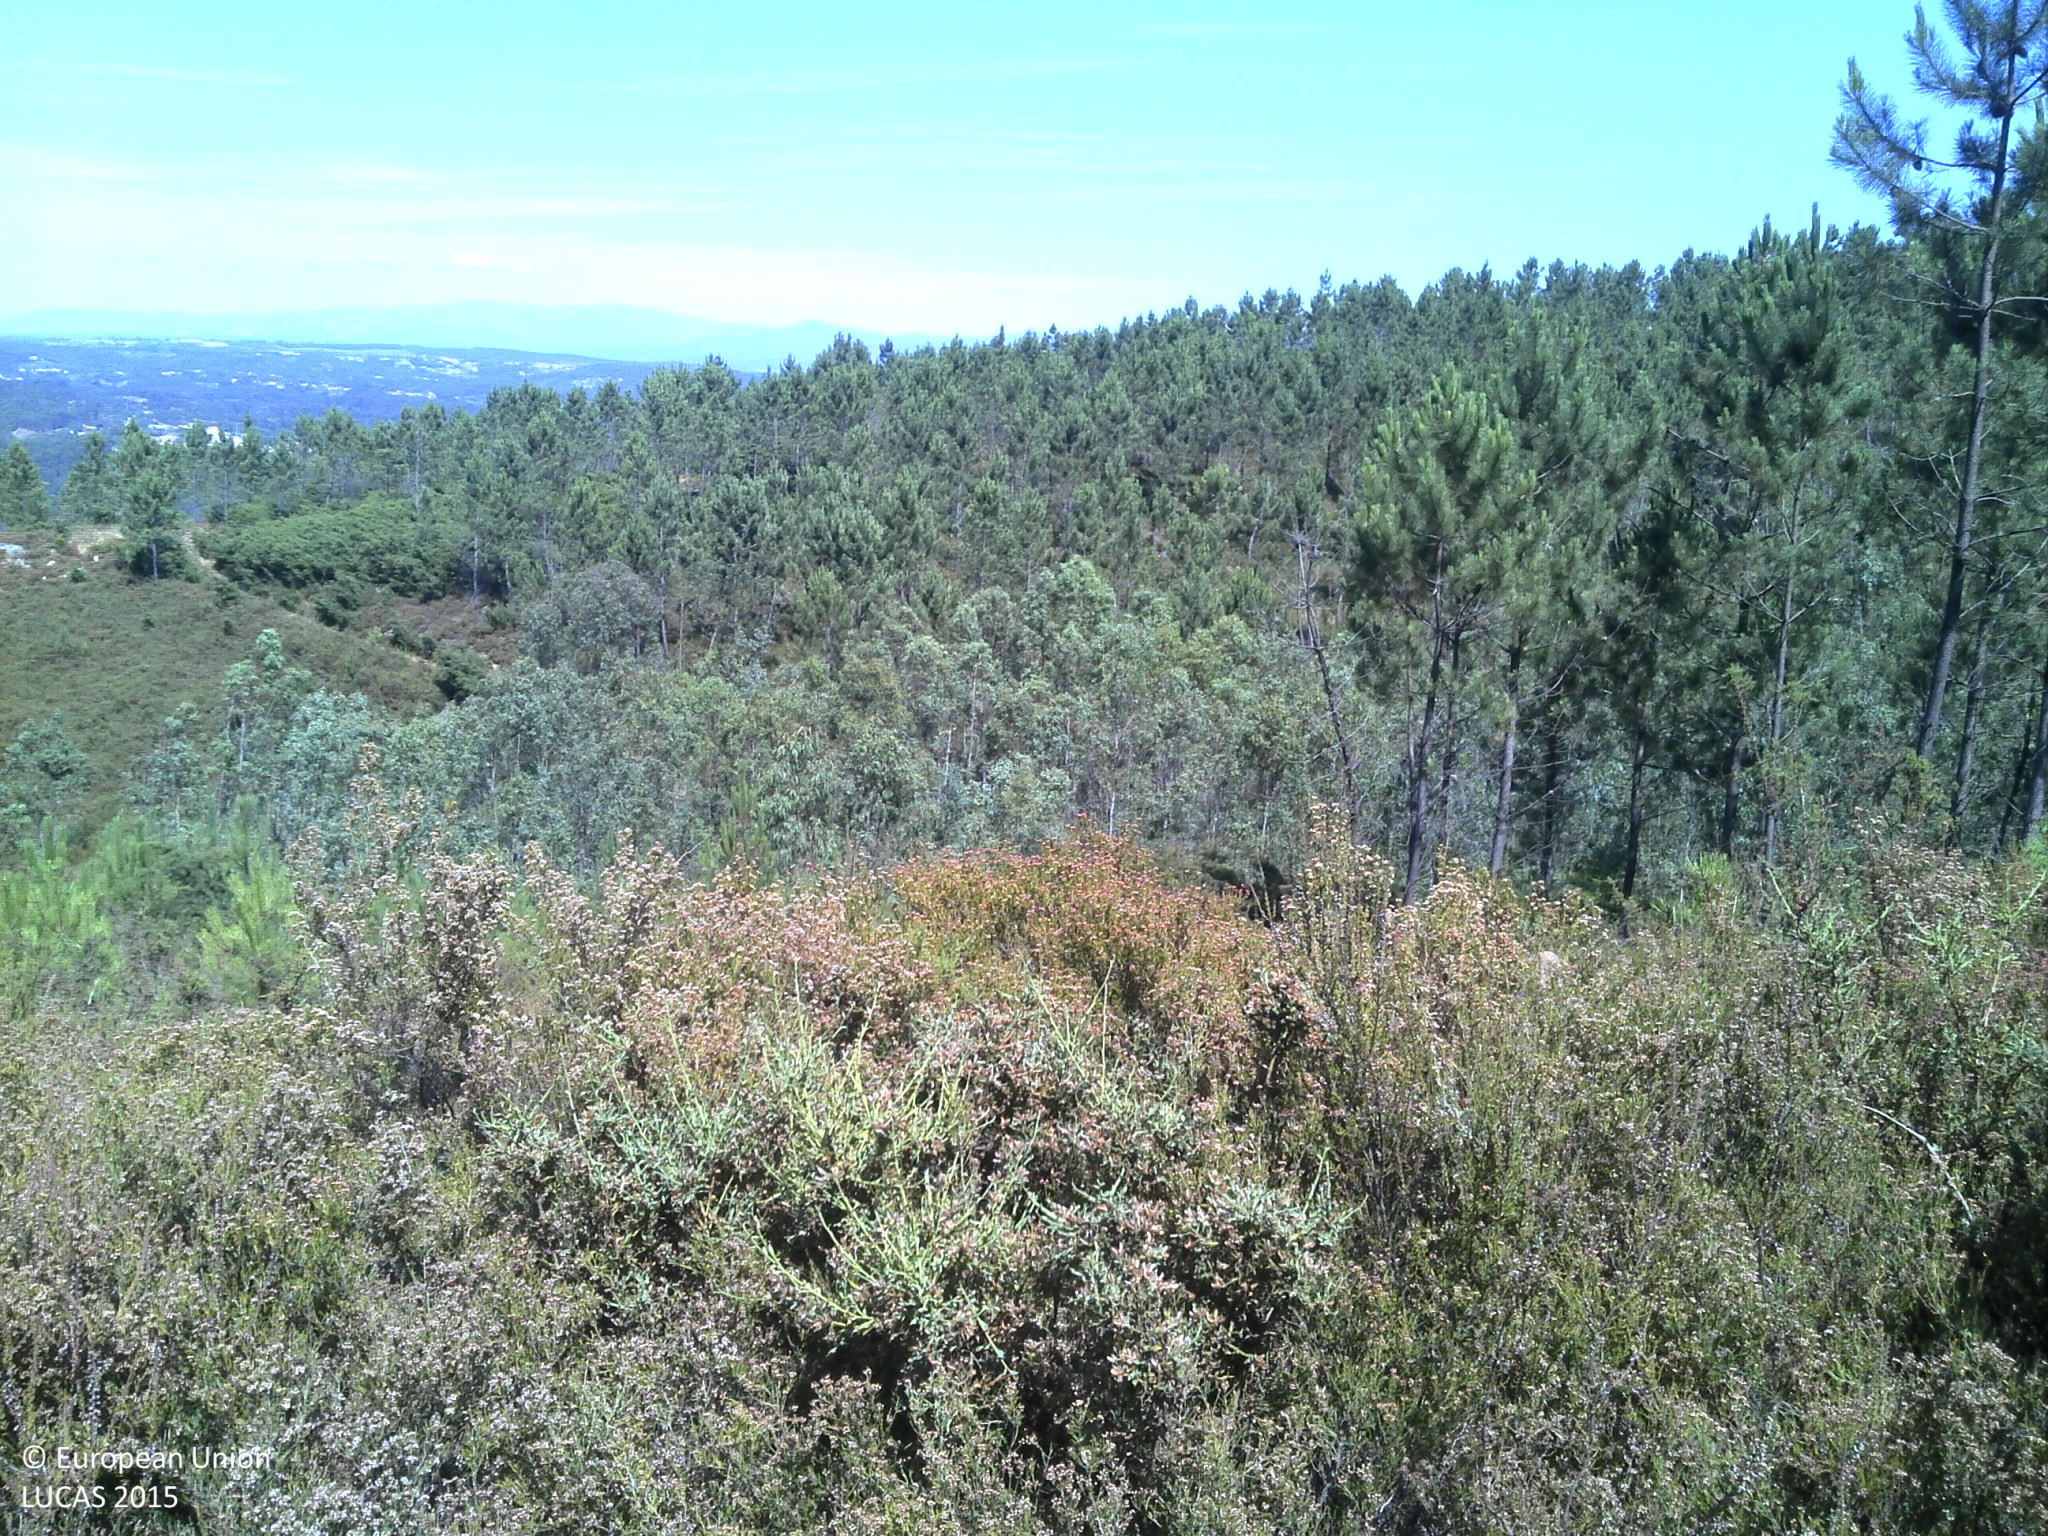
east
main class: Woodland
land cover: Pine dominated coniferous woodland
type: coniferous forest of the mediterranean region
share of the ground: 50 - 75 %
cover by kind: coniferous forest trees 50 %, shrubs 40 %, unconsolidated bare surface 10 %
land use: Forestry
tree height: > 5 m
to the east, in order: Pine dominated coniferous woodland; Shrubland without tree cover; Shrubland with sparse tree cover; Tracks; Shrubland with sparse tree cover; Pine dominated coniferous woodland; Broadleaved woodland; Pine dominated coniferous woodland
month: July
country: PT
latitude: 40.2463
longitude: -8.2172
